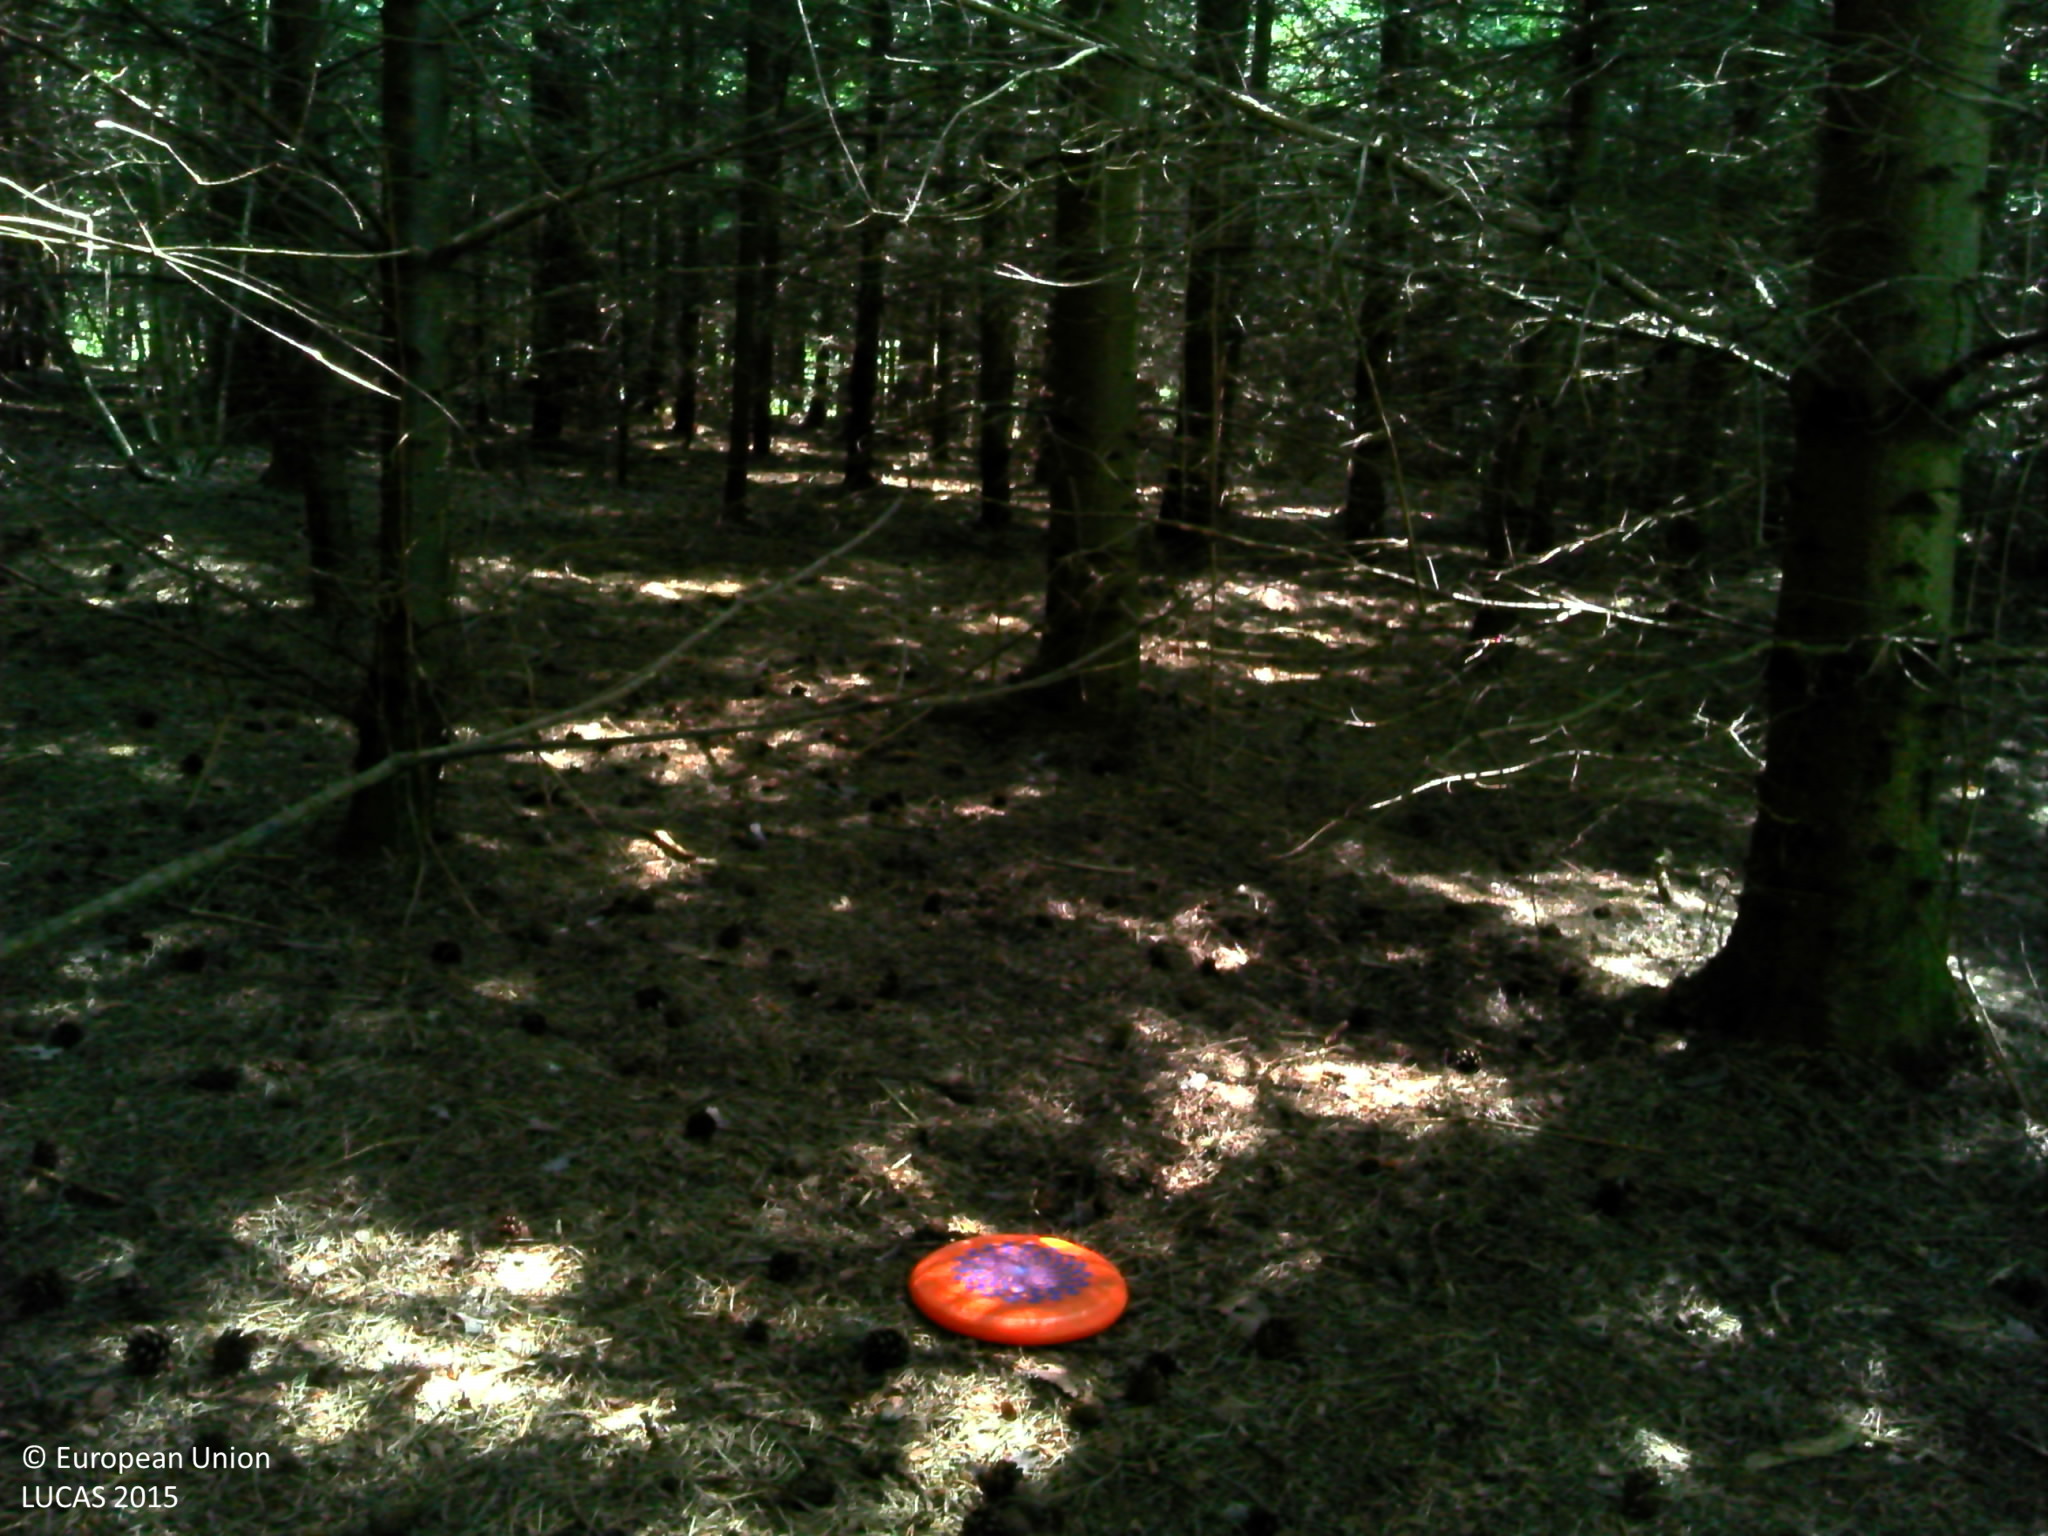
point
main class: Woodland
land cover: Other coniferous woodland
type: hemiboreal forest and nemoral coniferous forest and mixed broadleaved-coniferous forest
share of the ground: > 75 %
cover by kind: coniferous forest trees 95 %, broadleaved forest trees 5 %
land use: Forestry
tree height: > 5 m
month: June
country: BE
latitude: 49.9804
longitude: 4.9070
